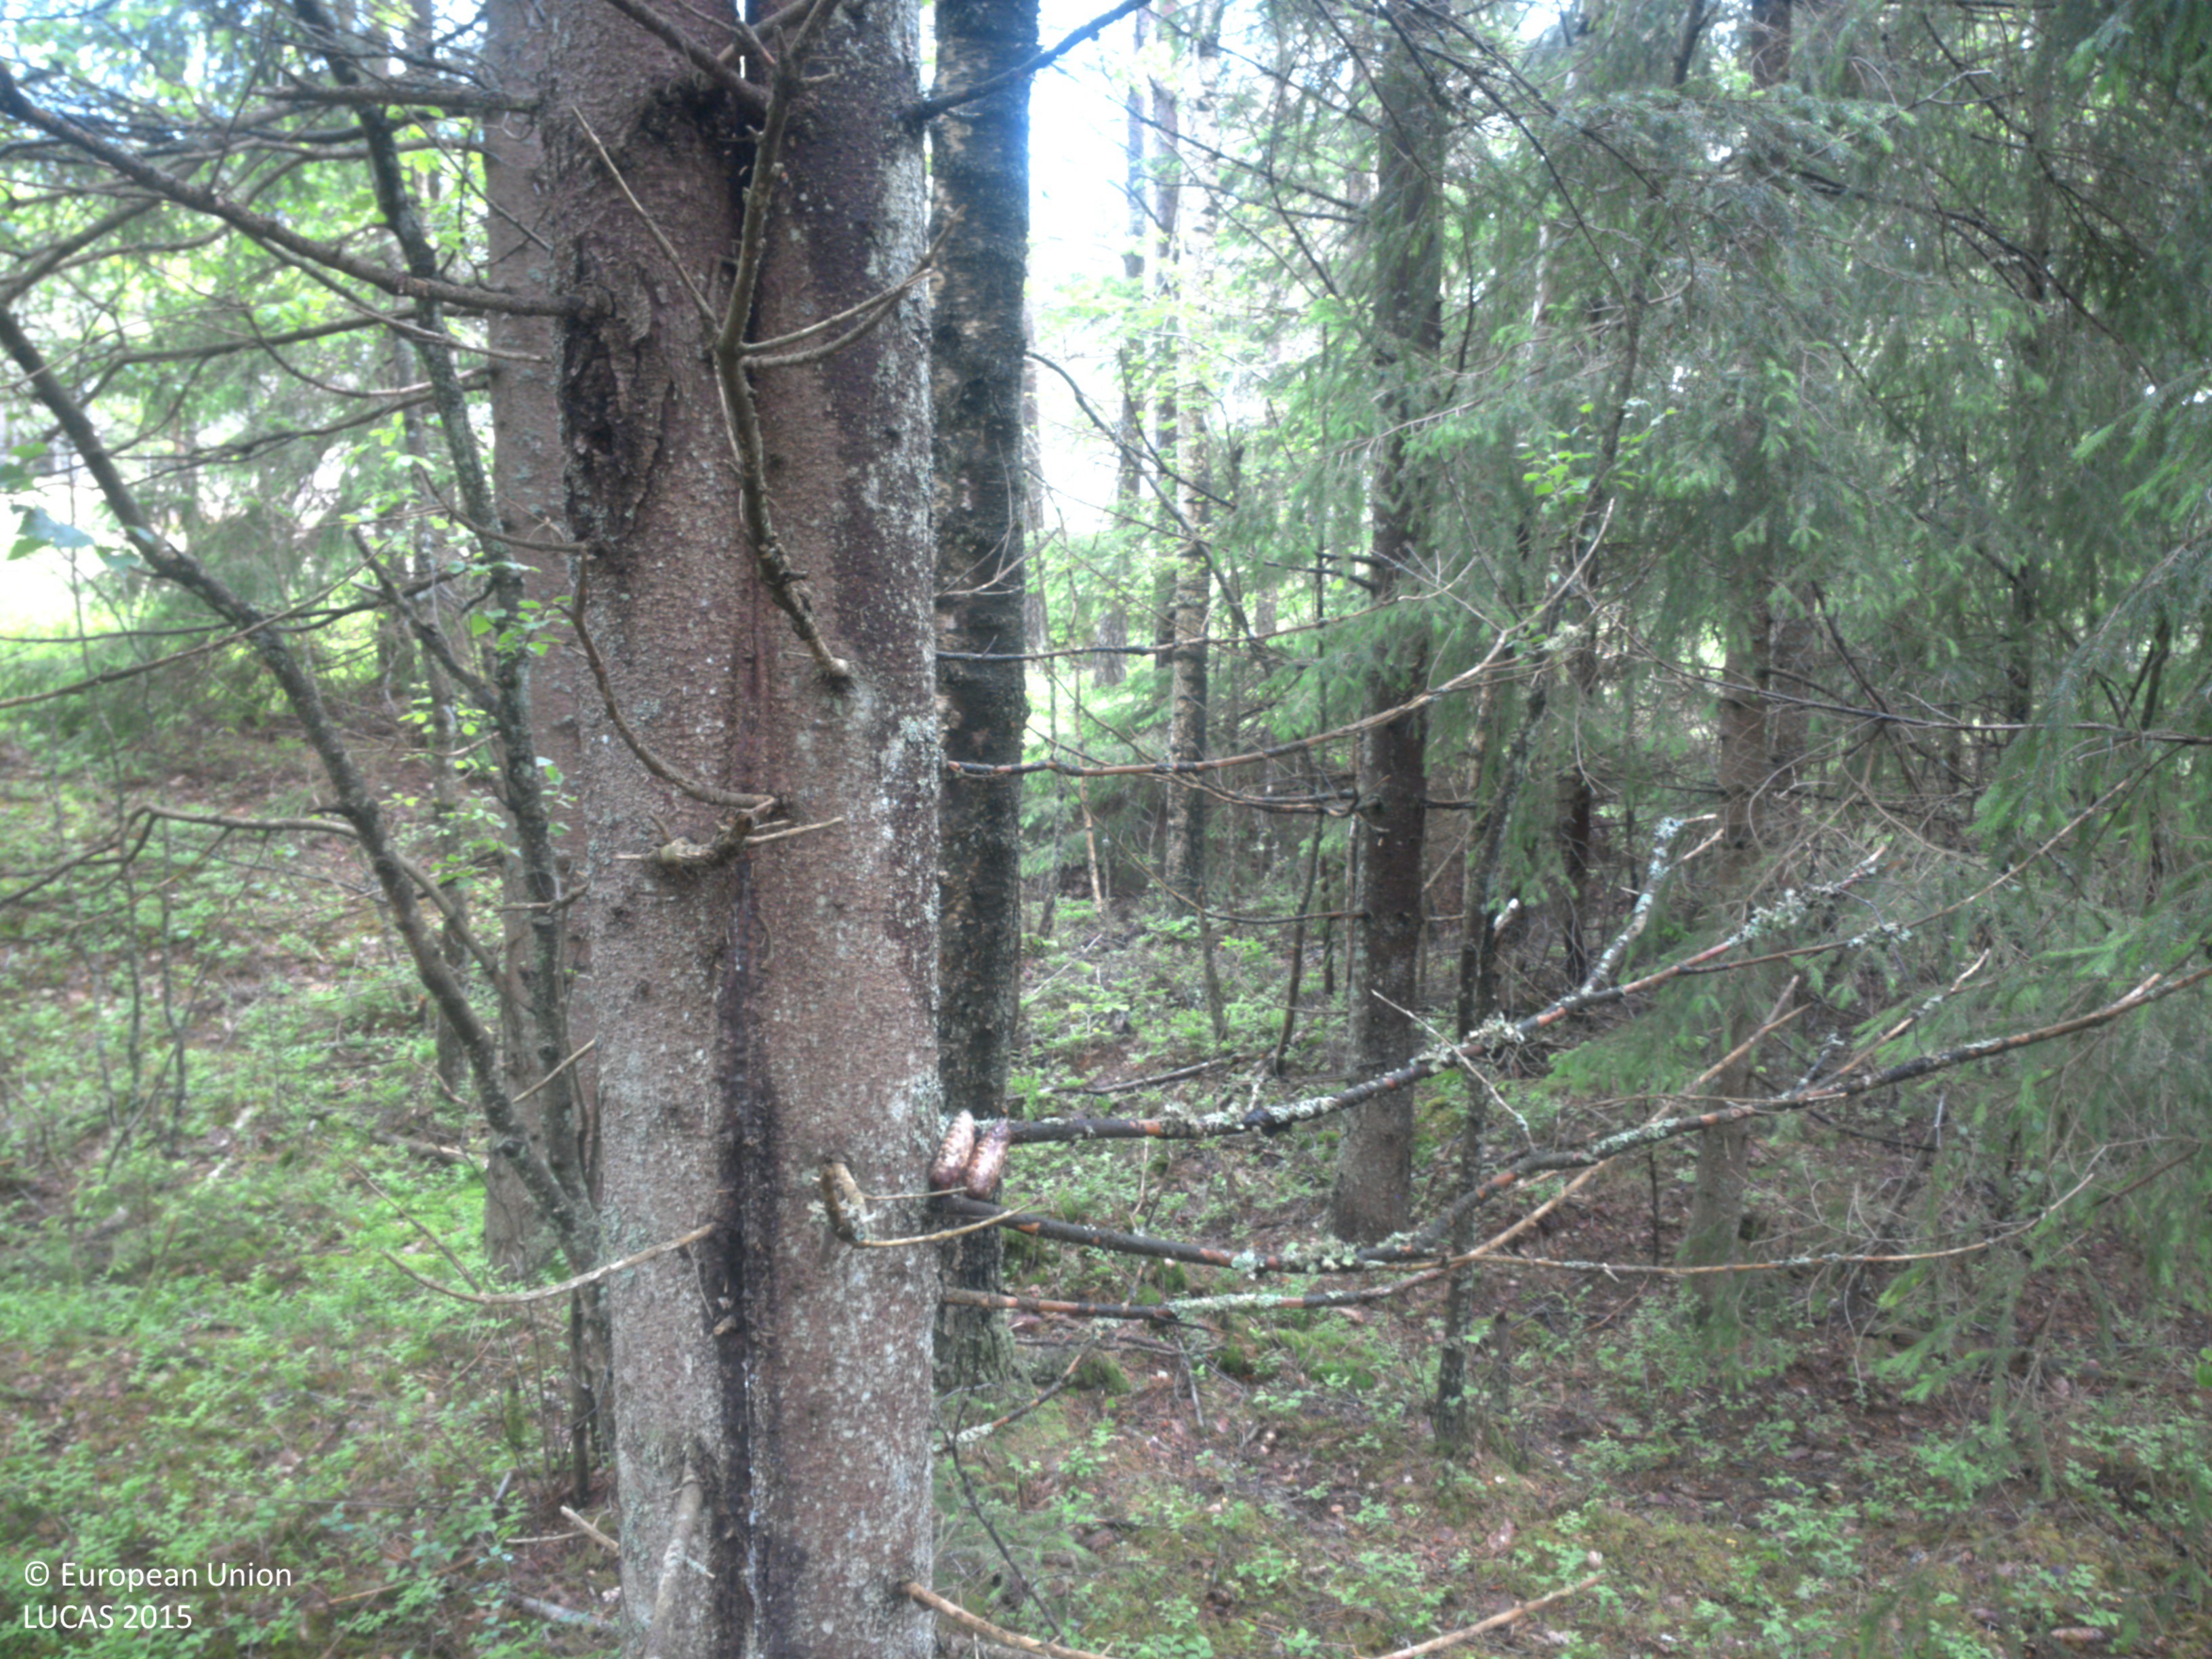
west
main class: Woodland
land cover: Spruce dominated coniferous woodland
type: boreal forest
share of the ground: 50 - 75 %
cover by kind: coniferous forest trees 50 %, lichens and mosses 40 %, broadleaved forest trees 5 %, shrubs 5 %
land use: Forestry
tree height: > 5 m
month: June
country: SE
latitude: 58.4773
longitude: 11.7968
